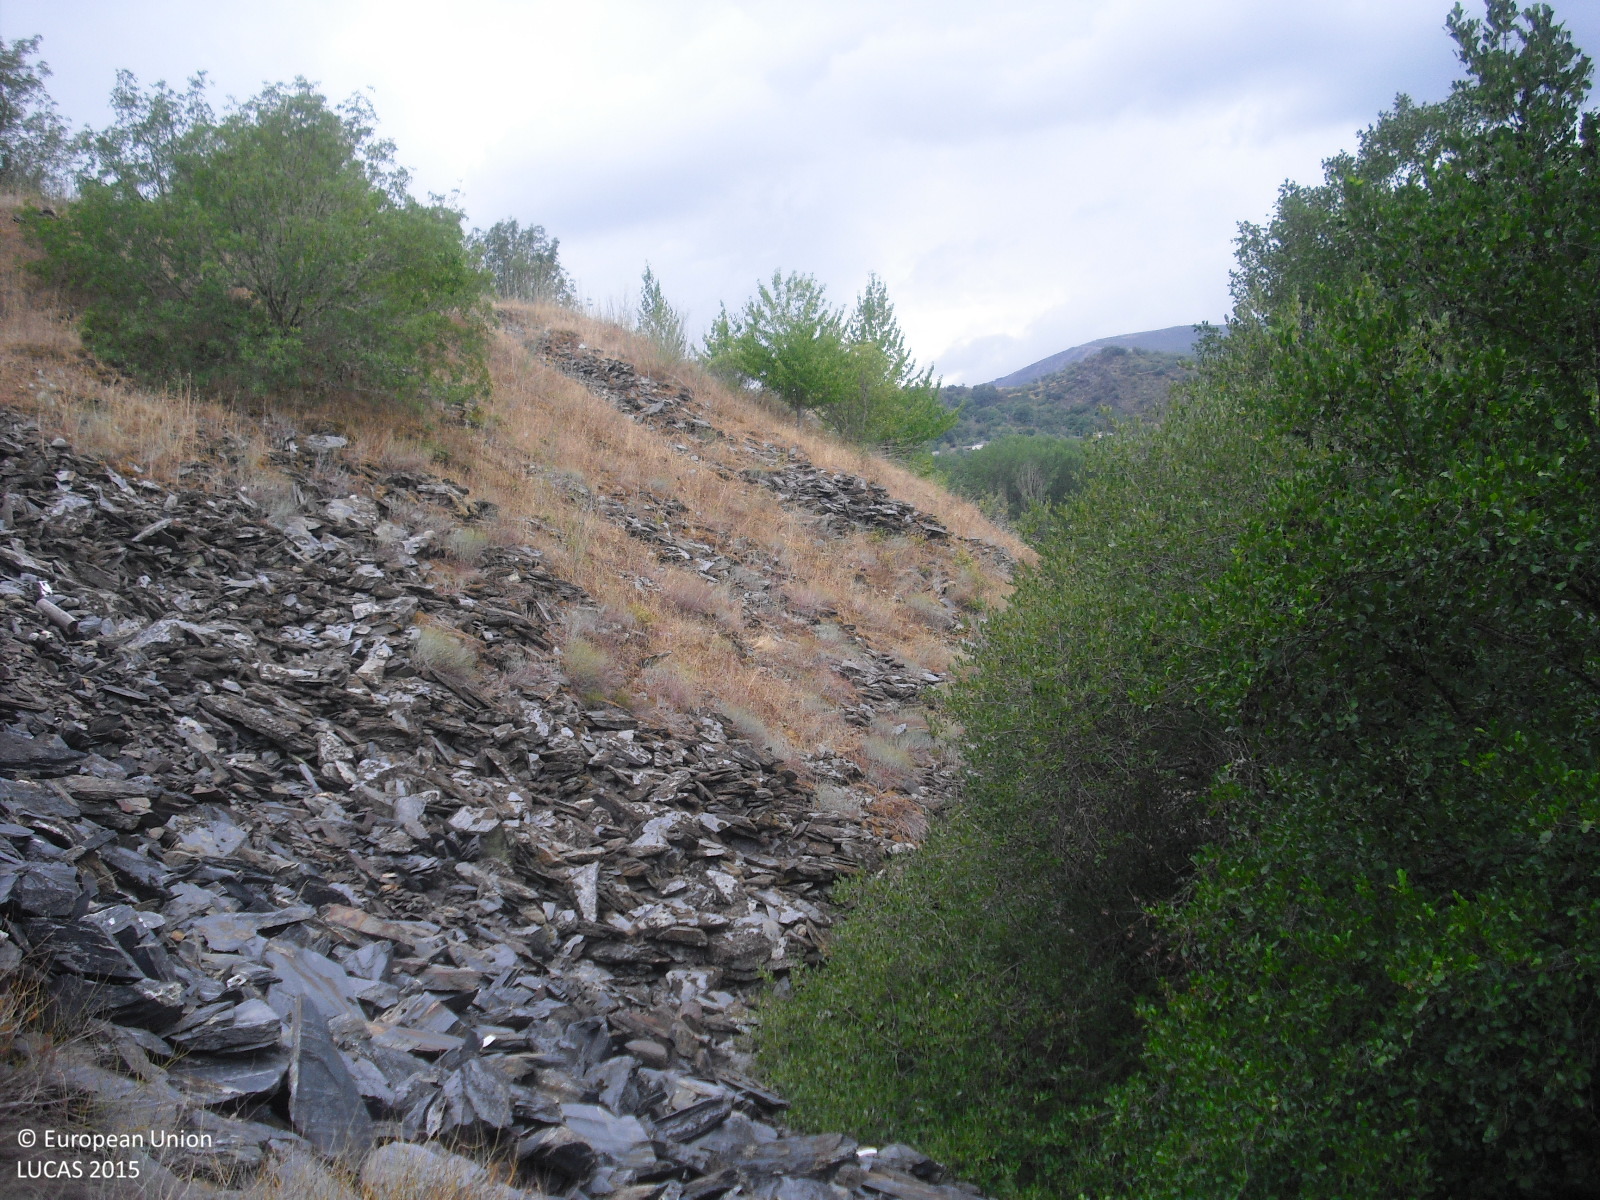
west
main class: Woodland
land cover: Broadleaved woodland
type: floodplain forest
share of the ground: 50 - 75 %
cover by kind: broadleaved forest trees 60 %, consolidated bare surface 30 %, shrubs 10 %
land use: Semi-natural and natural areas not in use
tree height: > 5 m
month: July
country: ES
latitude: 42.3858
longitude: -7.1982
